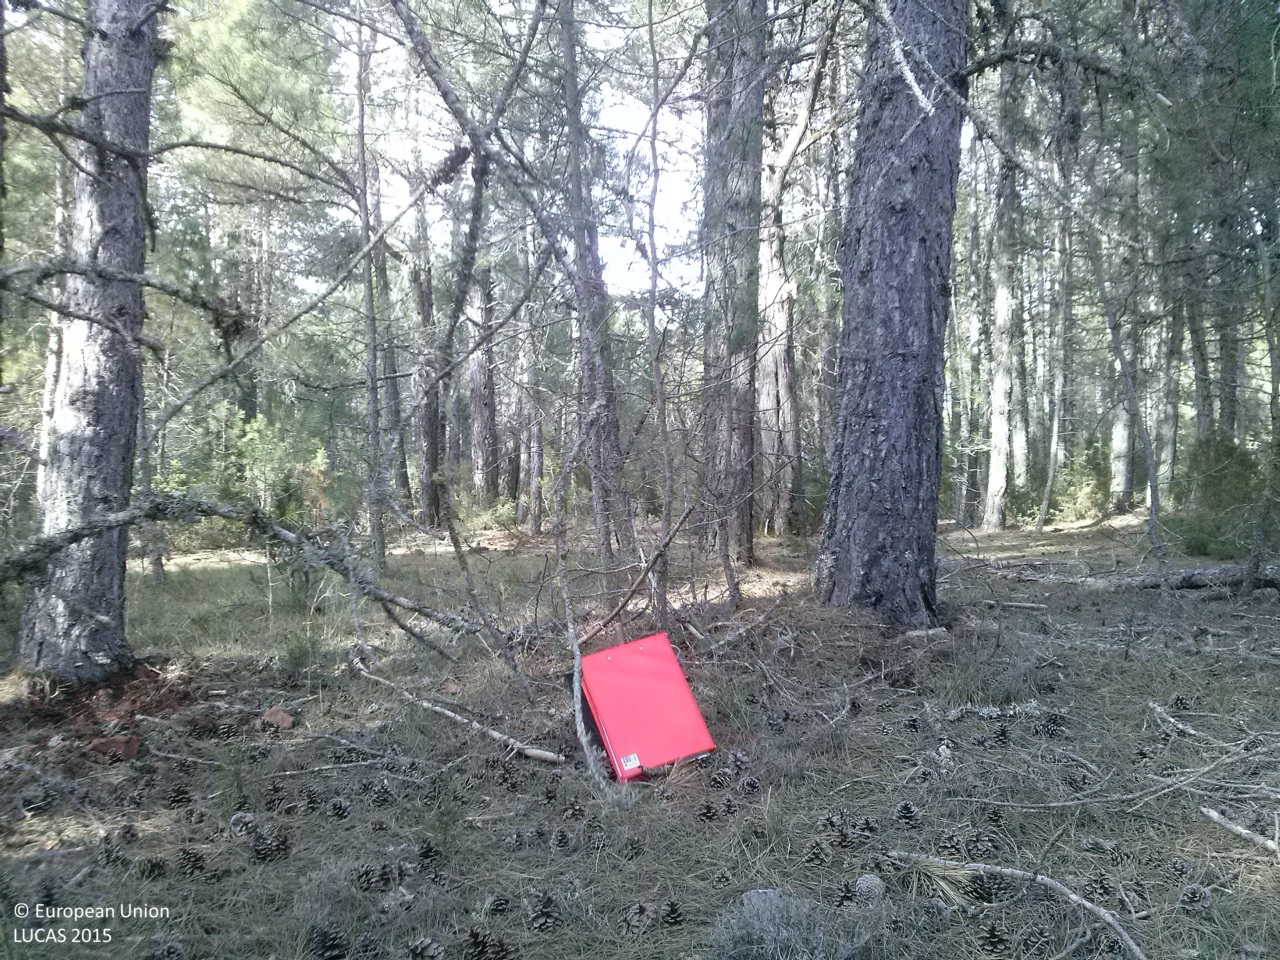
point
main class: Woodland
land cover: Pine dominated coniferous woodland
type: coniferous forest of the mediterranean region
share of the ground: 50 - 75 %
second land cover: Grassland without tree/shrub cover
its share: 10 - 25 %
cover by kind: coniferous forest trees 80 %, herbaceous plants 15 %, shrubs 5 %
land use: Forestry
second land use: Agriculture (excluding fallow land and kitchen gardens)
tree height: > 5 m
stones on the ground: 25 - 50 %
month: April
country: ES
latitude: 40.1247
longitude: -1.9015
